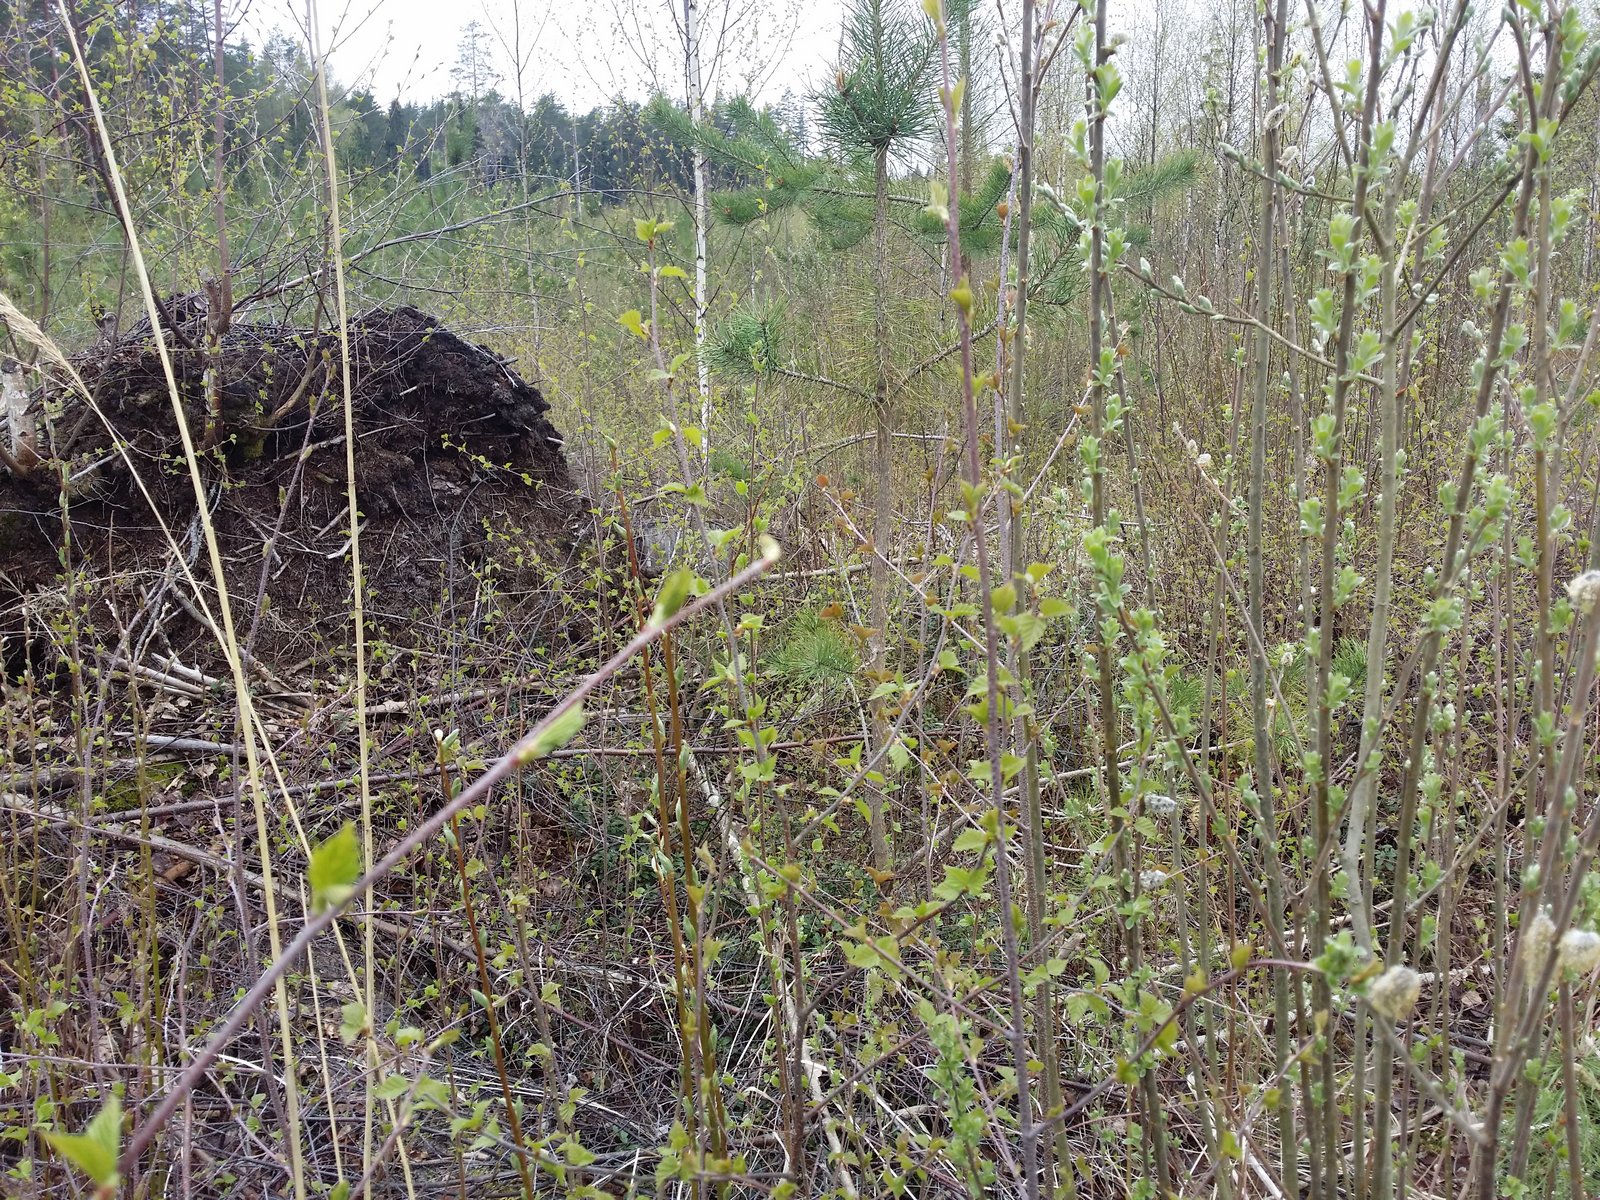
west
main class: Woodland
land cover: Other mixed woodland
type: hemiboreal forest and nemoral coniferous forest and mixed broadleaved-coniferous forest
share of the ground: 50 - 75 %
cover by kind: coniferous forest trees 40 %, broadleaved forest trees 40 %, lichens and mosses 20 %
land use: Forestry
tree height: < 5 m
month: May
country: LV
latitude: 57.4348
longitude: 26.0034
